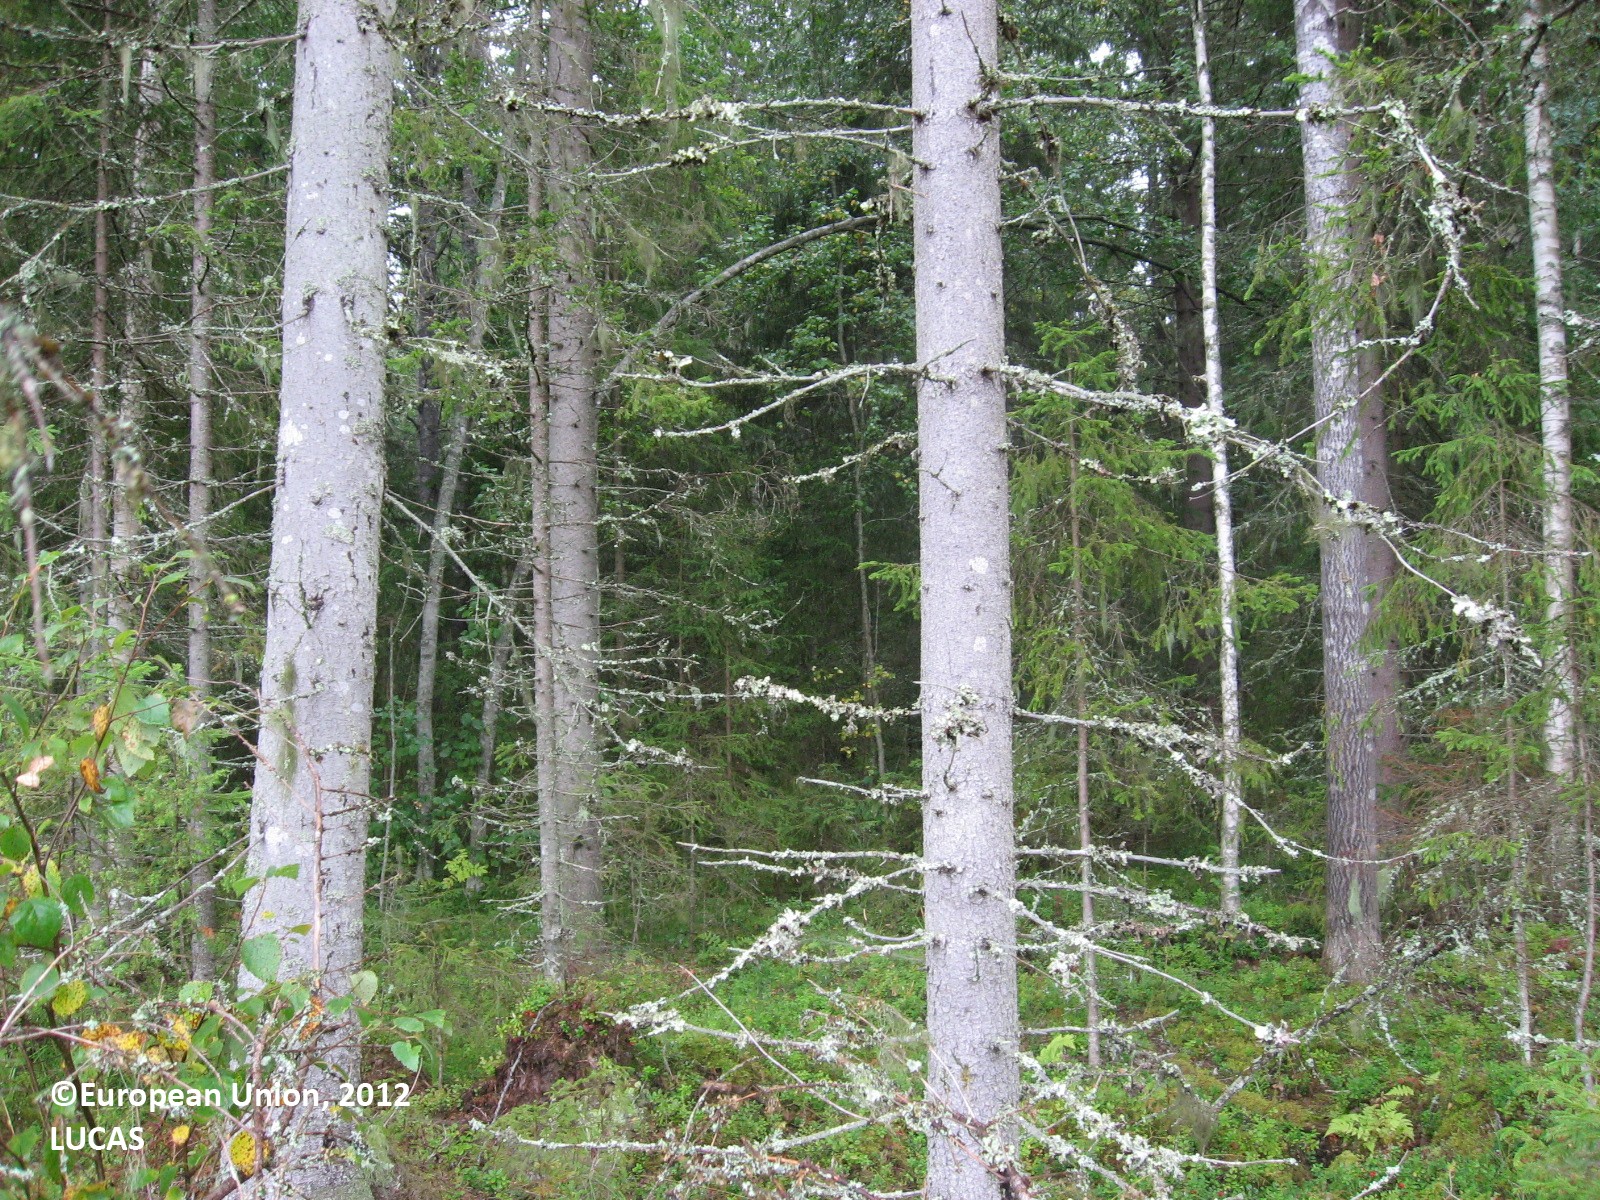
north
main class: Woodland
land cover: Spruce dominated mixed woodland
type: boreal forest
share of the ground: > 75 %
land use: Forestry
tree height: > 5 m
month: August
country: FI
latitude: 61.3598
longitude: 24.9787
